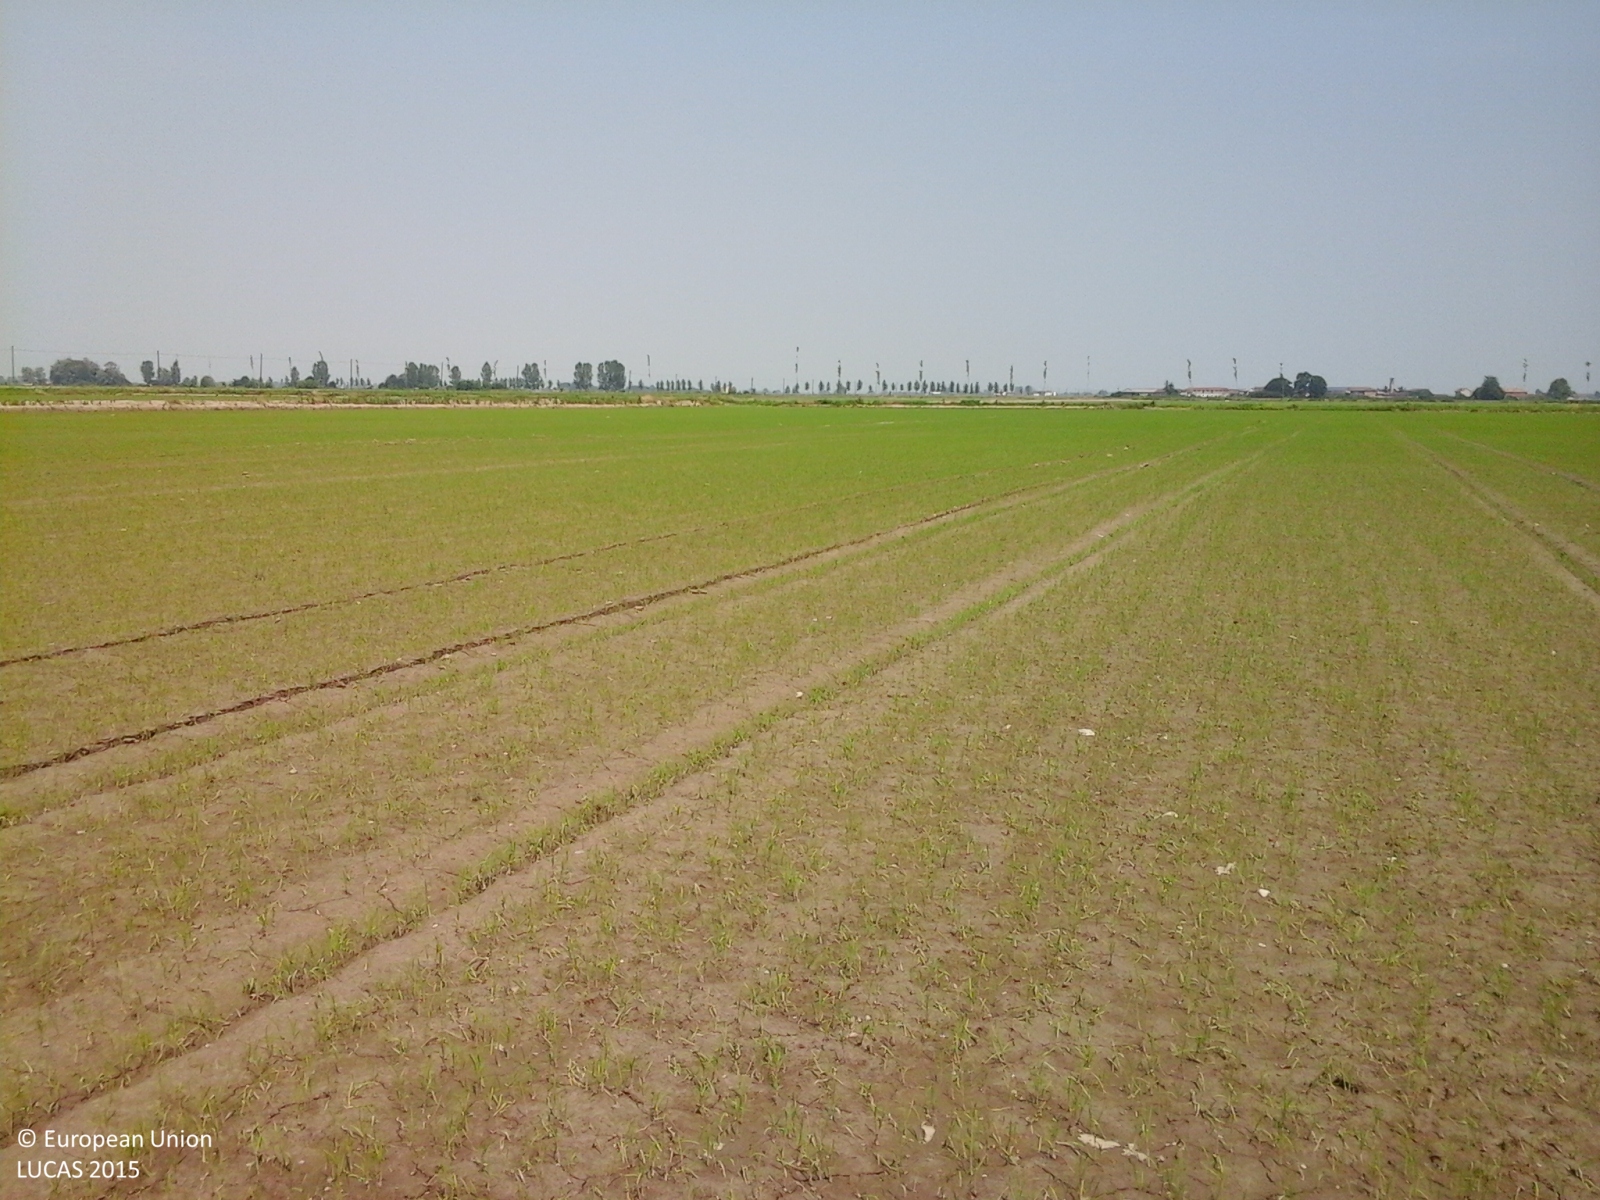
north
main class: Cropland
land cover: Rice
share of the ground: 10 - 25 %
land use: Agriculture (excluding fallow land and kitchen gardens)
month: May
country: IT
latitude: 45.3110
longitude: 8.3320
